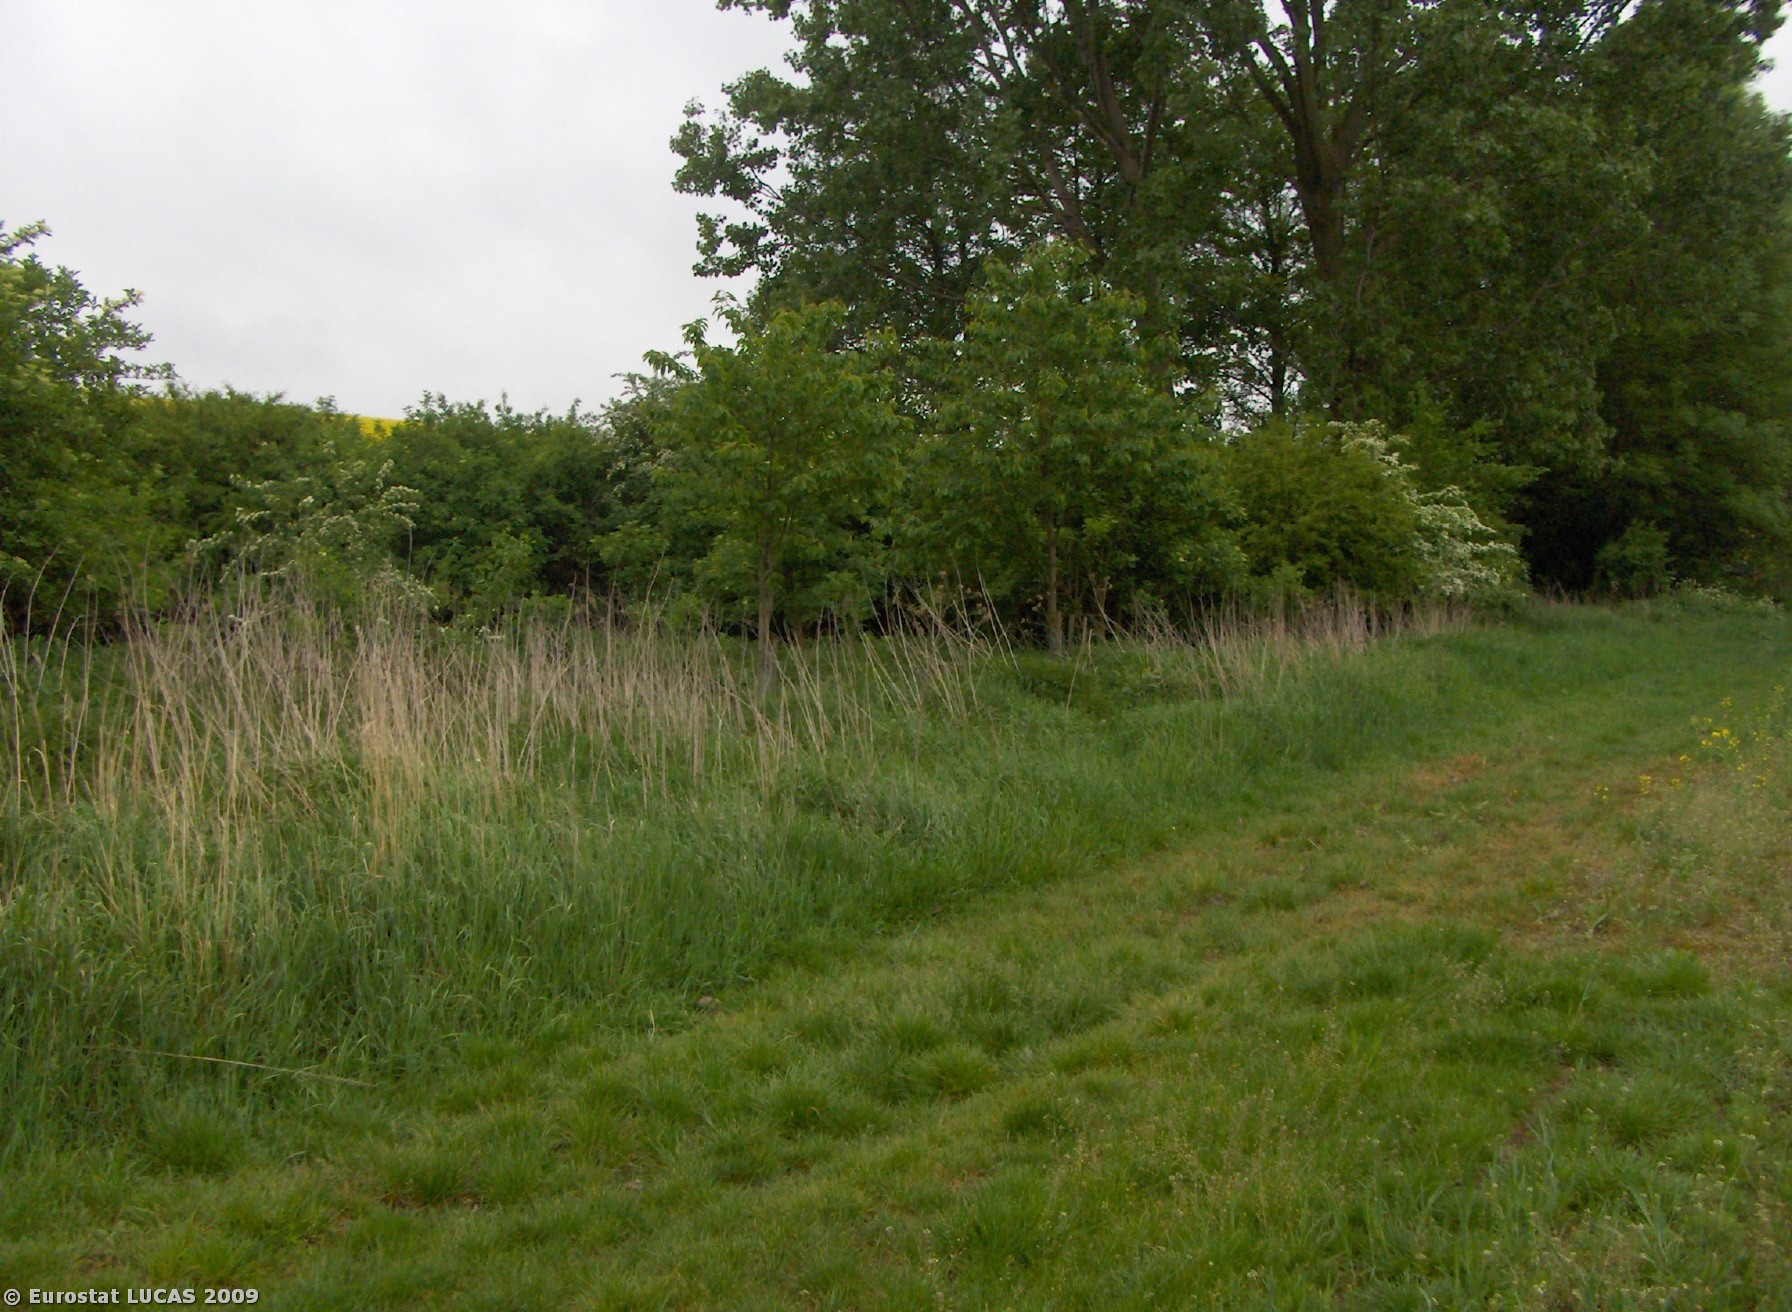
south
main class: Cropland
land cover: Common wheat
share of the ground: > 75 %
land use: Agriculture (excluding fallow land and kitchen gardens)
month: May
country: CZ
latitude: 49.3311
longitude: 17.0964
